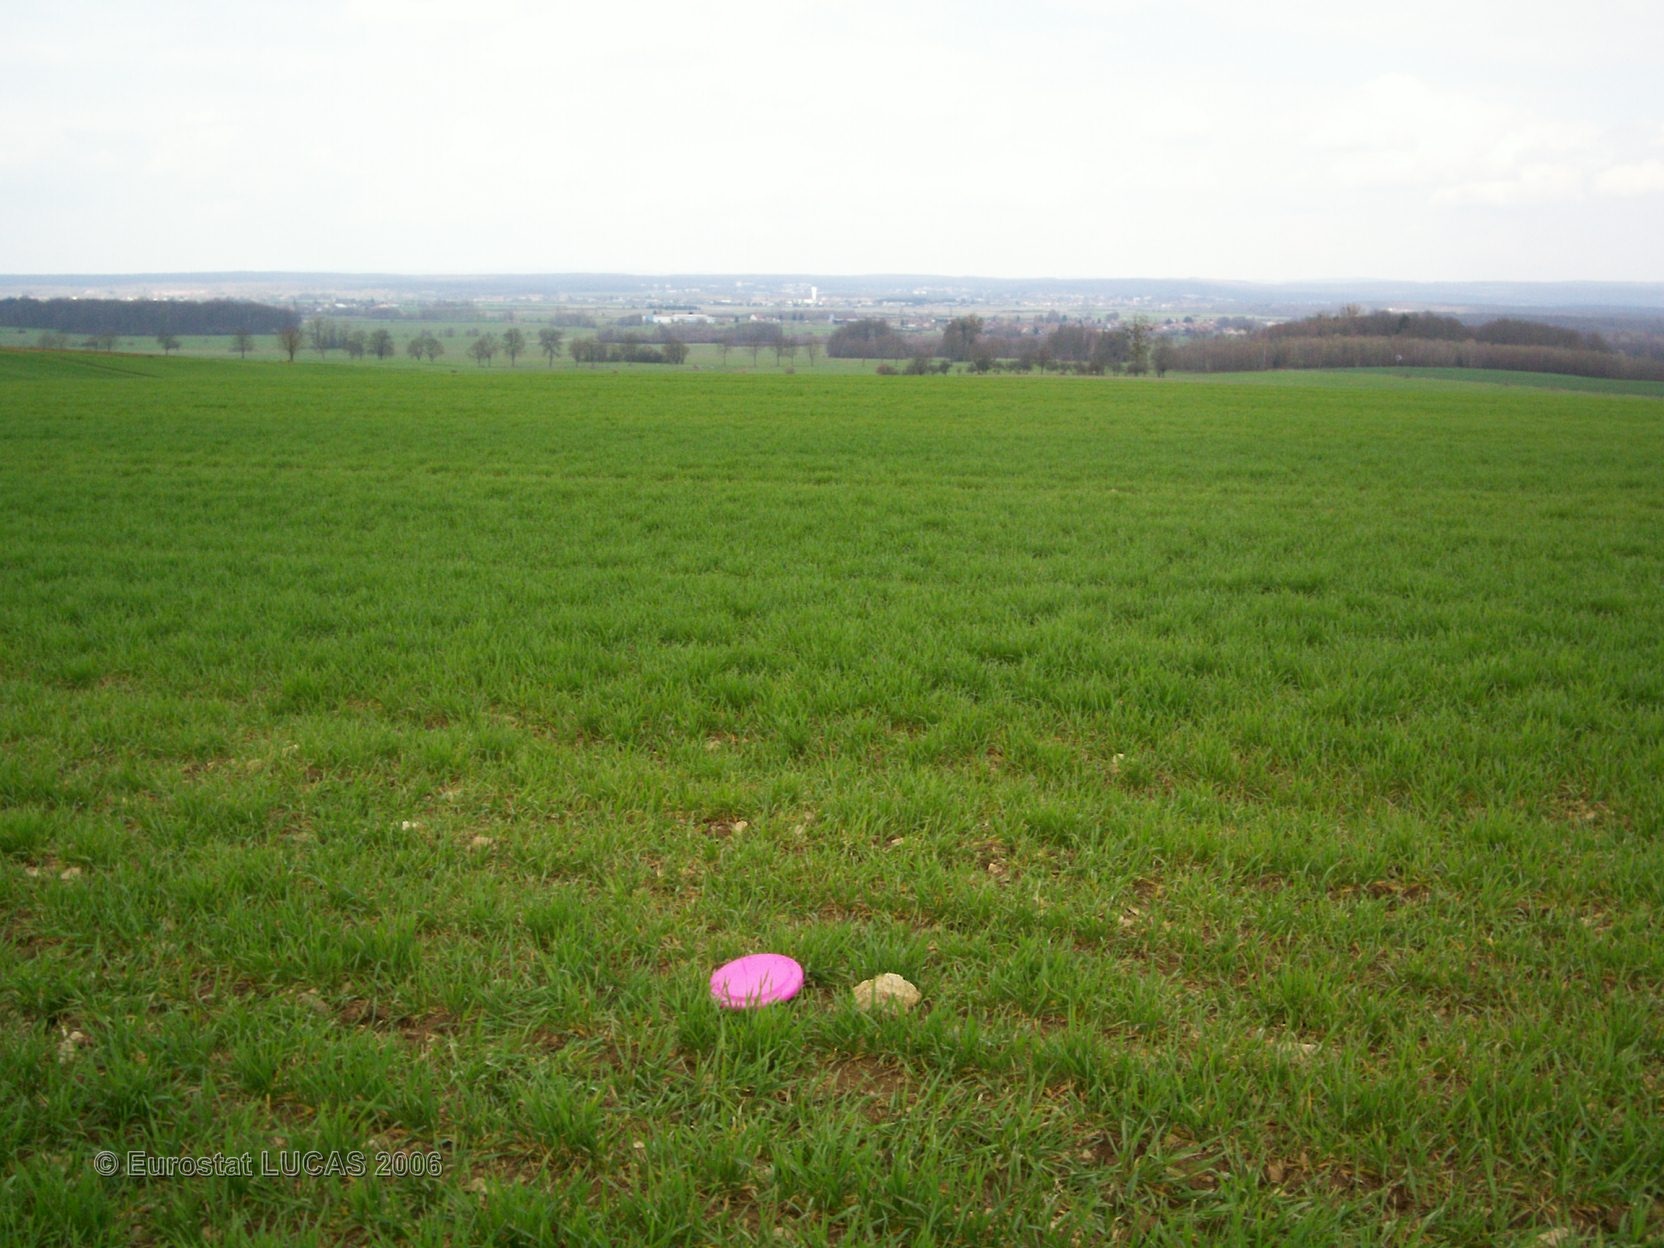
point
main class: Cropland
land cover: Common wheat
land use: Agriculture (excluding fallow land and kitchen gardens)
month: April
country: FR
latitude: 47.7491
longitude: 6.3599
